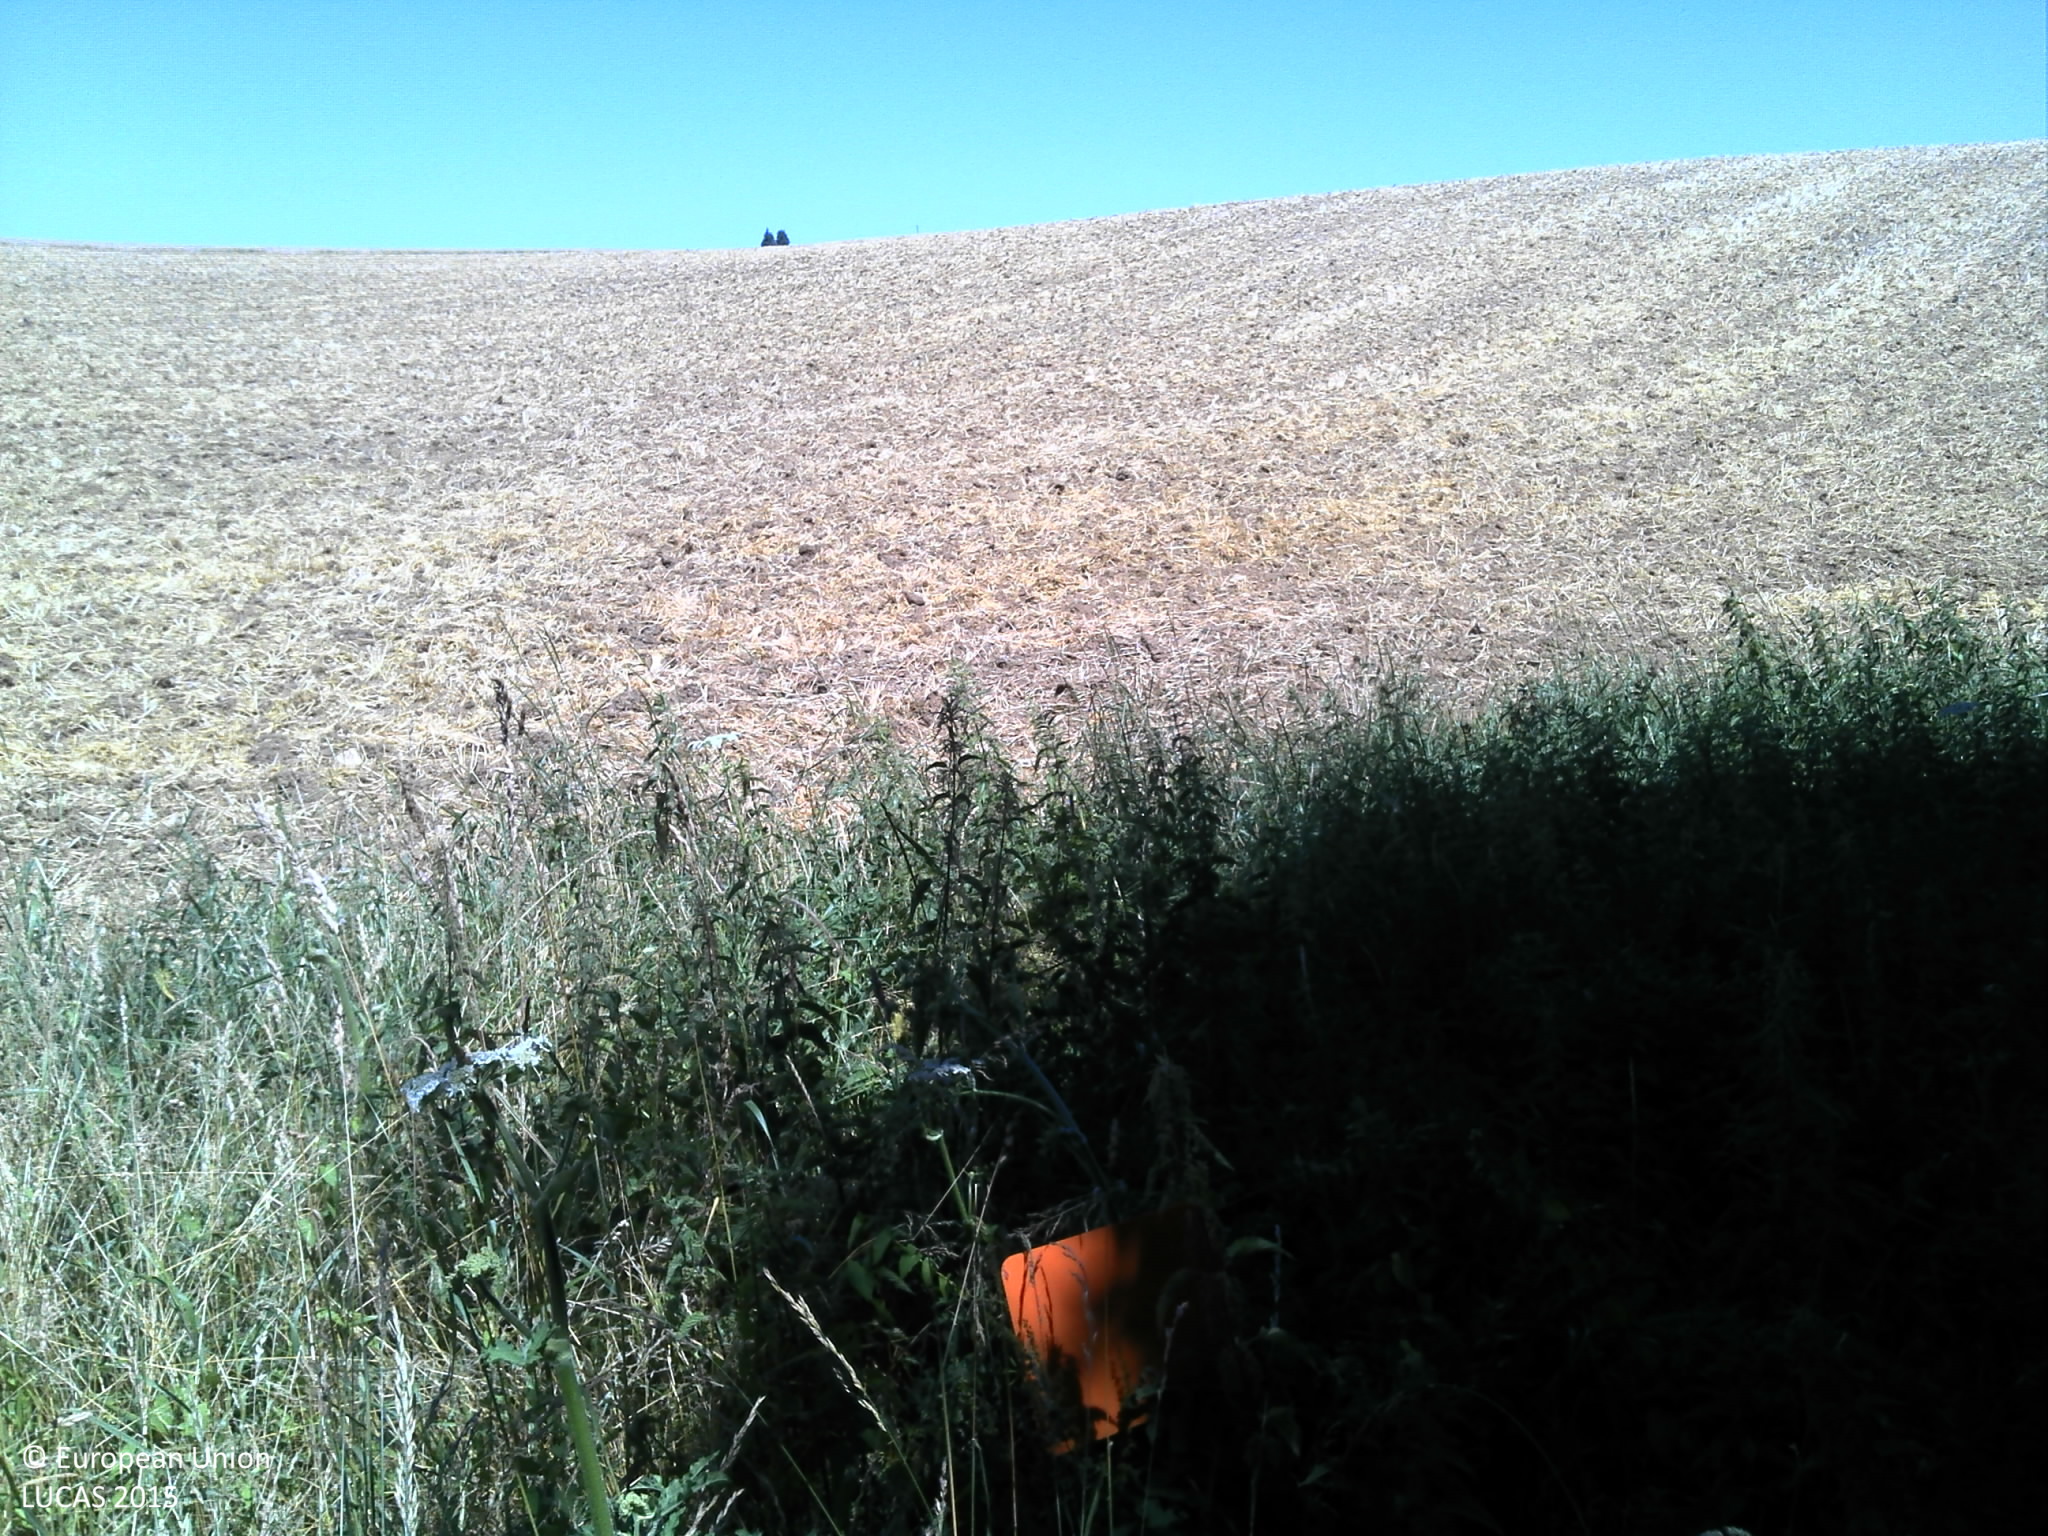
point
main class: Grassland
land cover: Grassland without tree/shrub cover
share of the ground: > 75 %
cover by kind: herbaceous plants 100 %
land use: Agriculture (excluding fallow land and kitchen gardens)
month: July
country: FR
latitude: 49.5718
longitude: 4.6451
